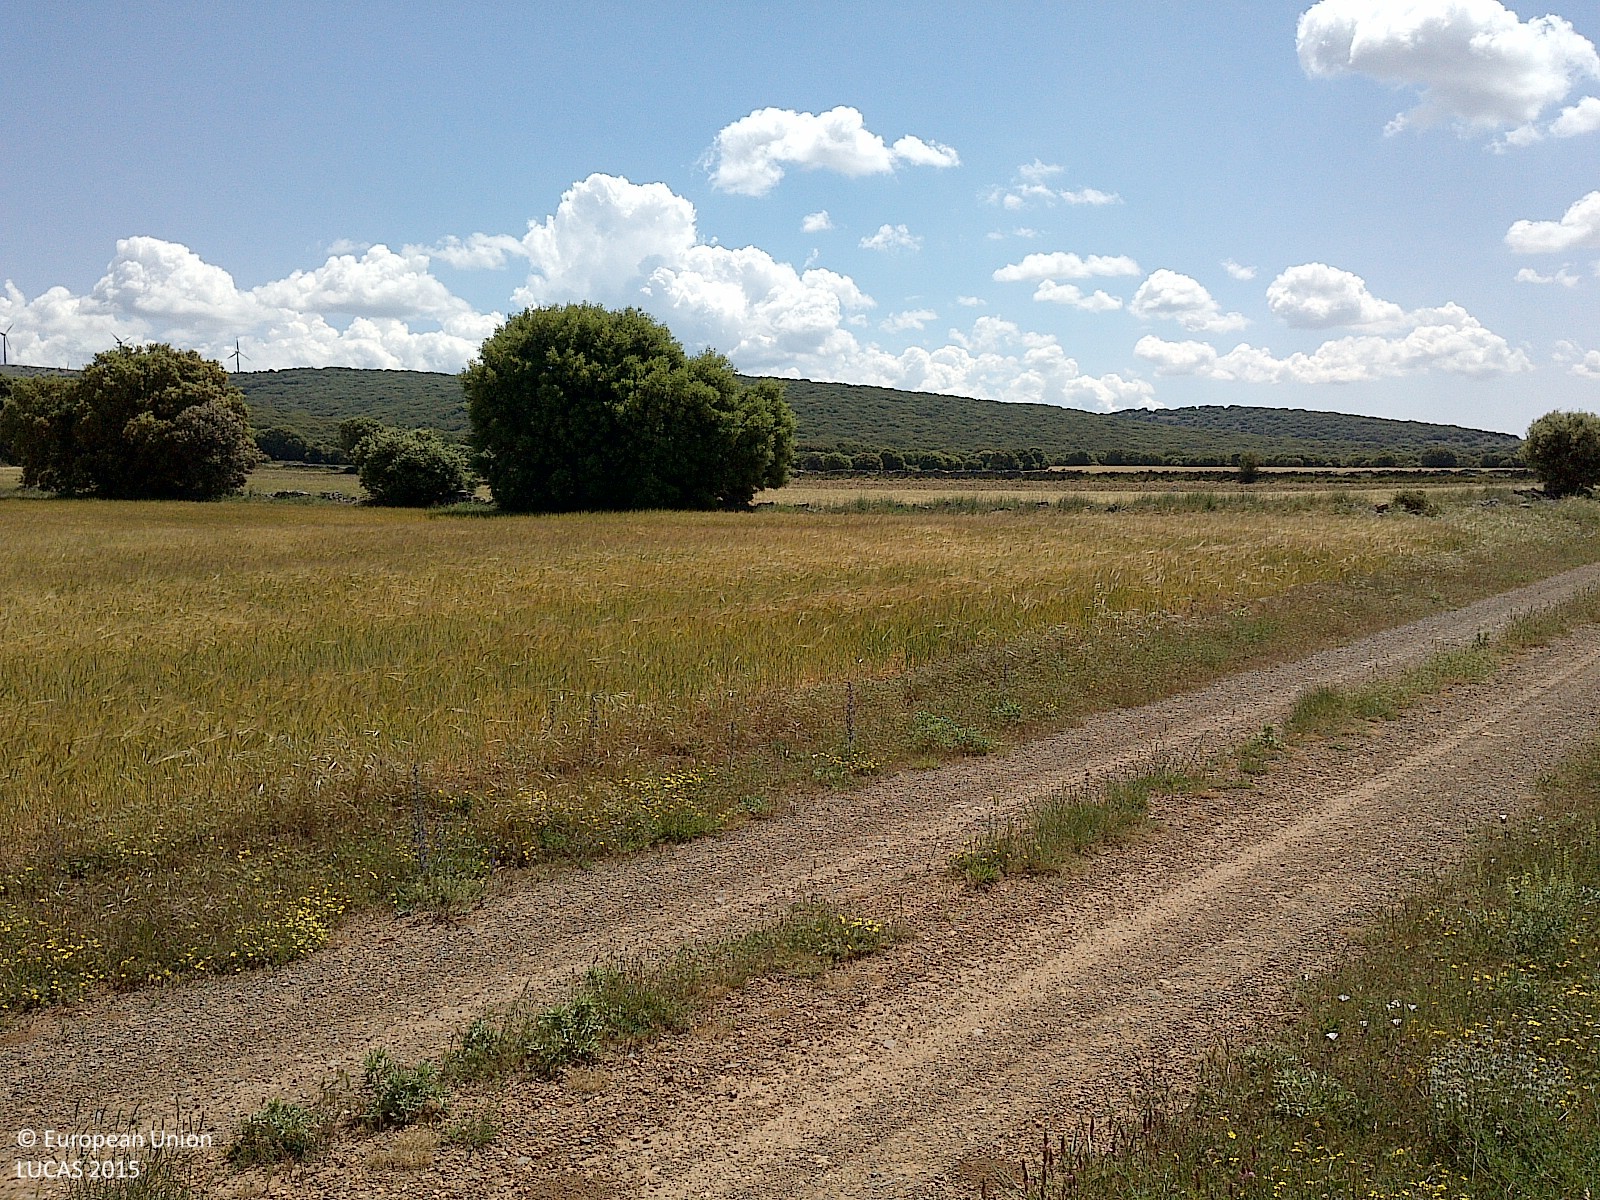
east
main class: Cropland
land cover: Barley
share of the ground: > 75 %
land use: Agriculture (excluding fallow land and kitchen gardens)
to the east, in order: Grass margins; Tracks; Grass margins; Barley; Grass margins; Dry stone walls; Grass margins; Barley; Spontaneously vegetated surfaces; Dry stone walls; Grass margins; Barley
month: June
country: ES
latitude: 41.7647
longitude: -2.0743
